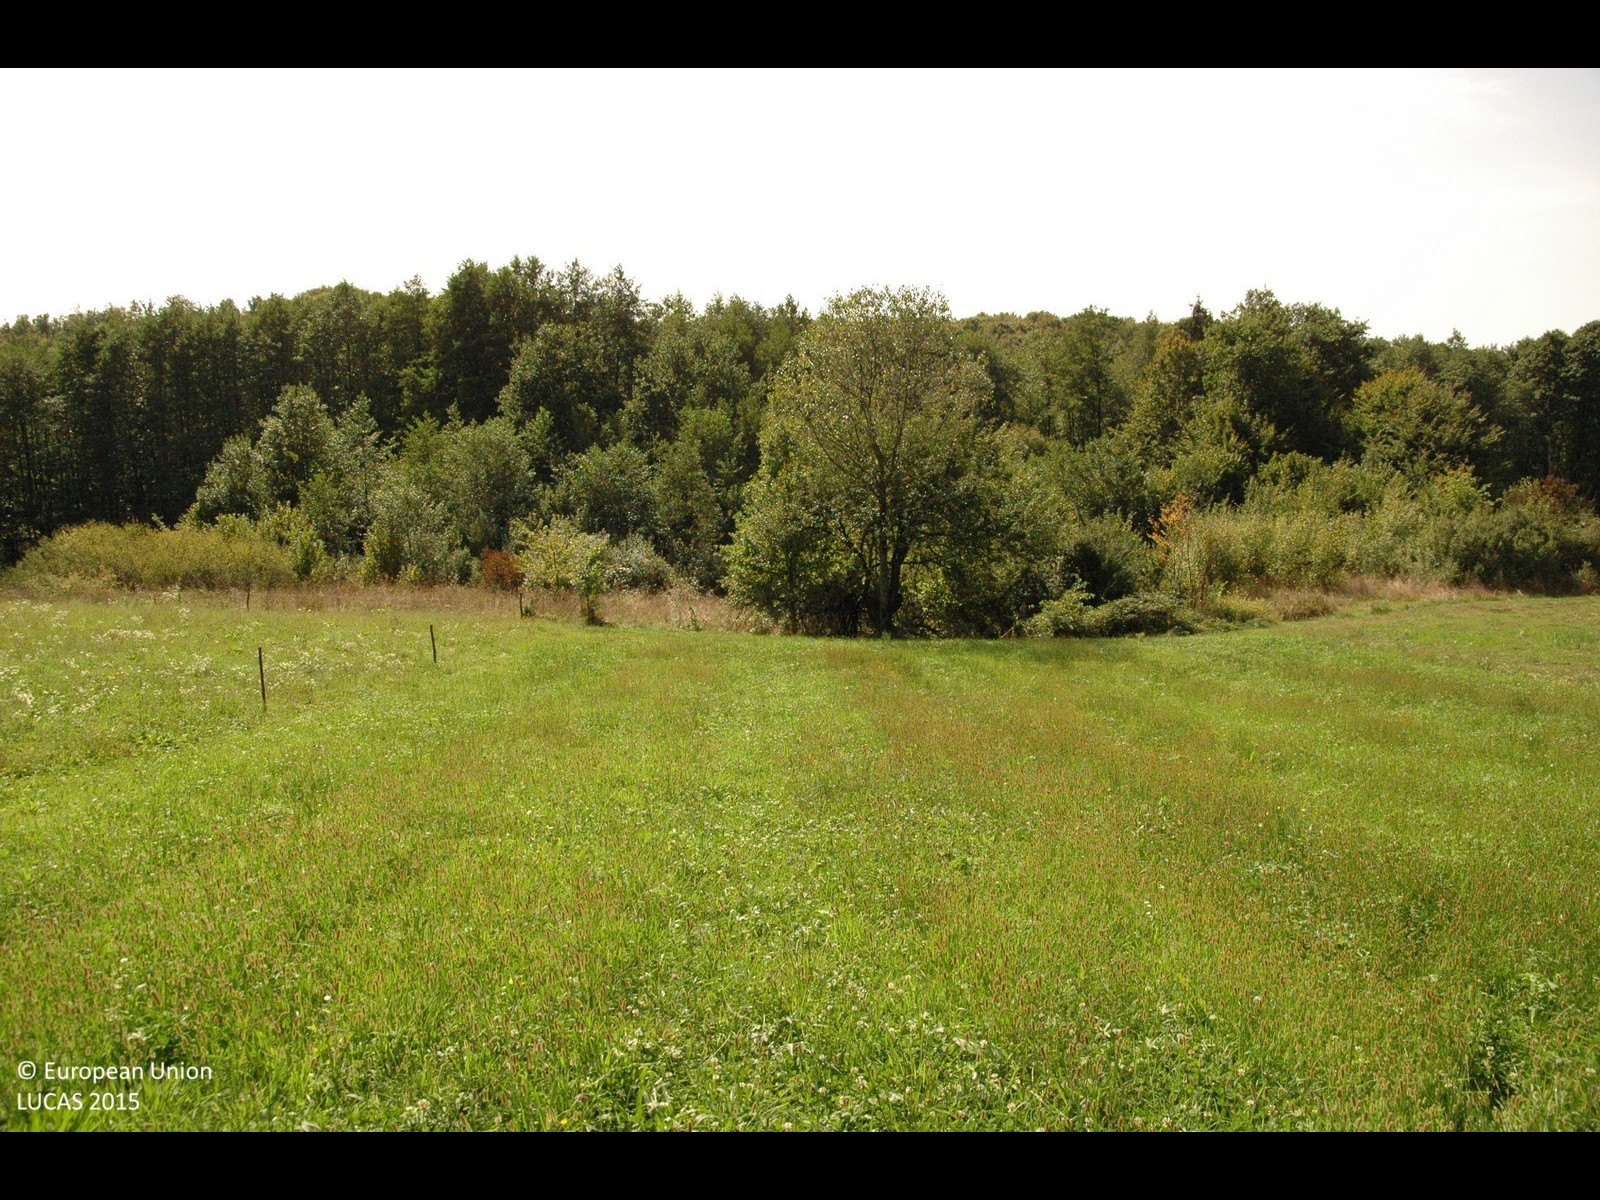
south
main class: Grassland
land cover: Grassland without tree/shrub cover
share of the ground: > 75 %
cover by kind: herbaceous plants 100 %
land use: Agriculture (excluding fallow land and kitchen gardens)
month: September
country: HR
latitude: 45.5352
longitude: 15.9517
